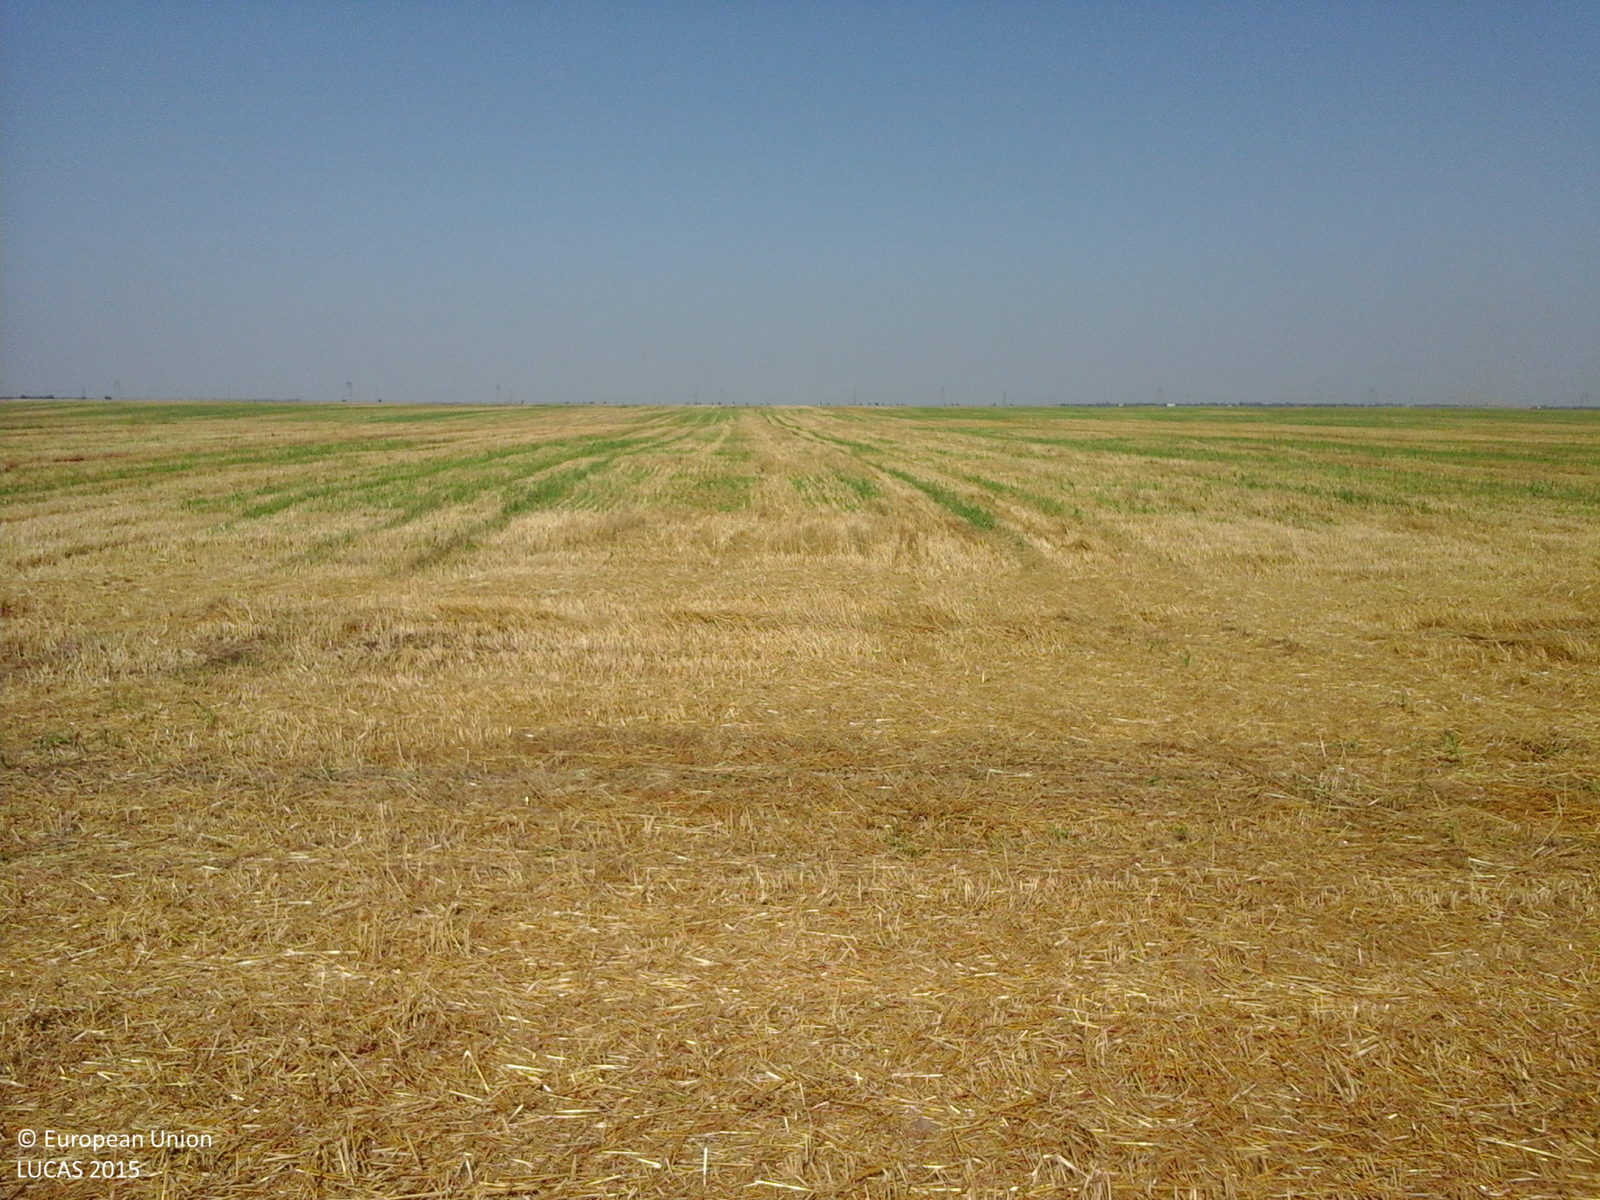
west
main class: Cropland
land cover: Common wheat
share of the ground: 10 - 25 %
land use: Agriculture (excluding fallow land and kitchen gardens)
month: July
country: RO
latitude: 44.3035
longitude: 27.3984
